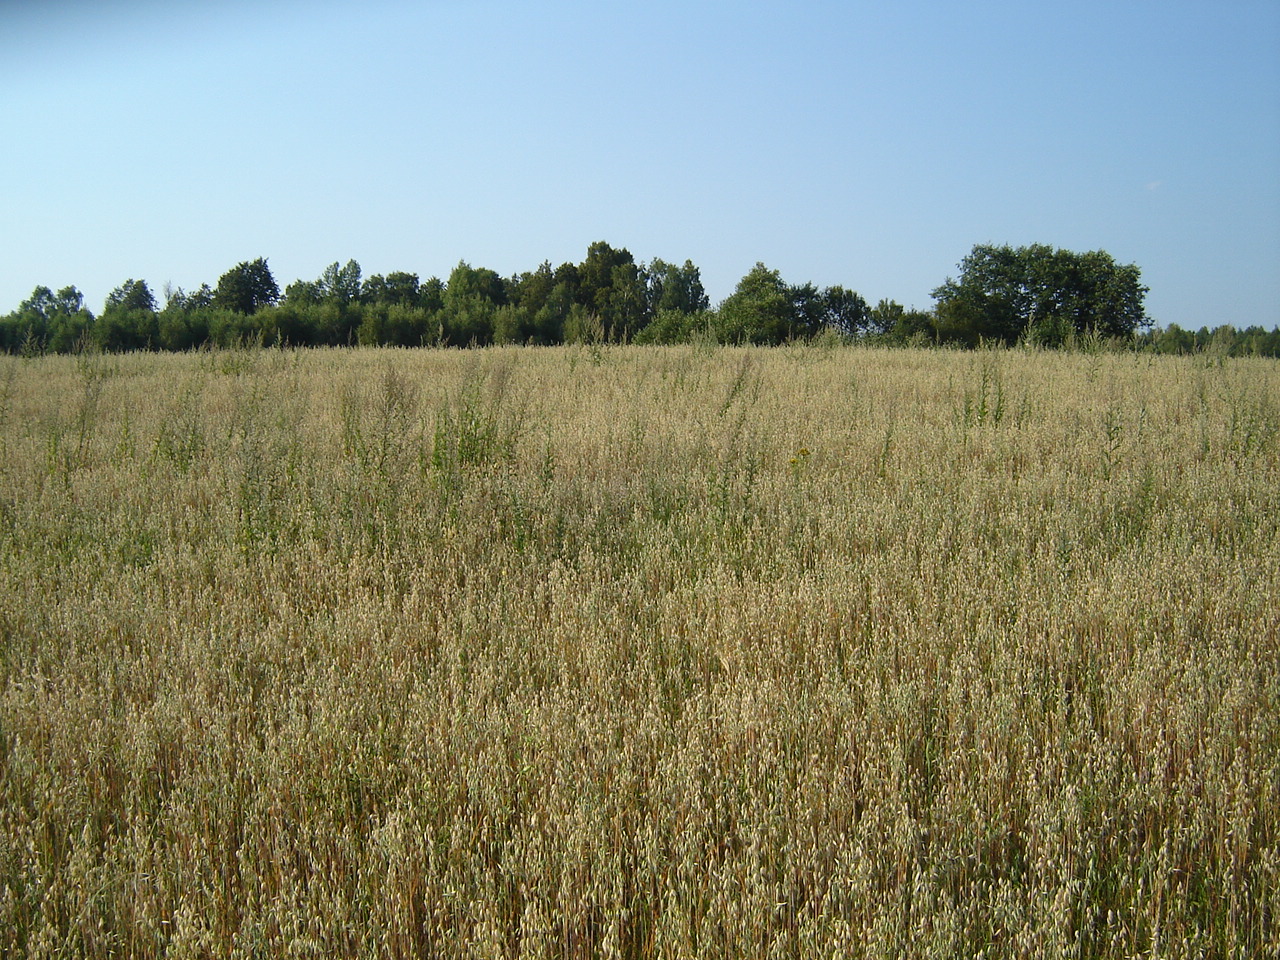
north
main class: Cropland
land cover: Oats
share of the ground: > 75 %
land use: Agriculture (excluding fallow land and kitchen gardens)
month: August
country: LT
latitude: 55.1977
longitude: 25.3771
